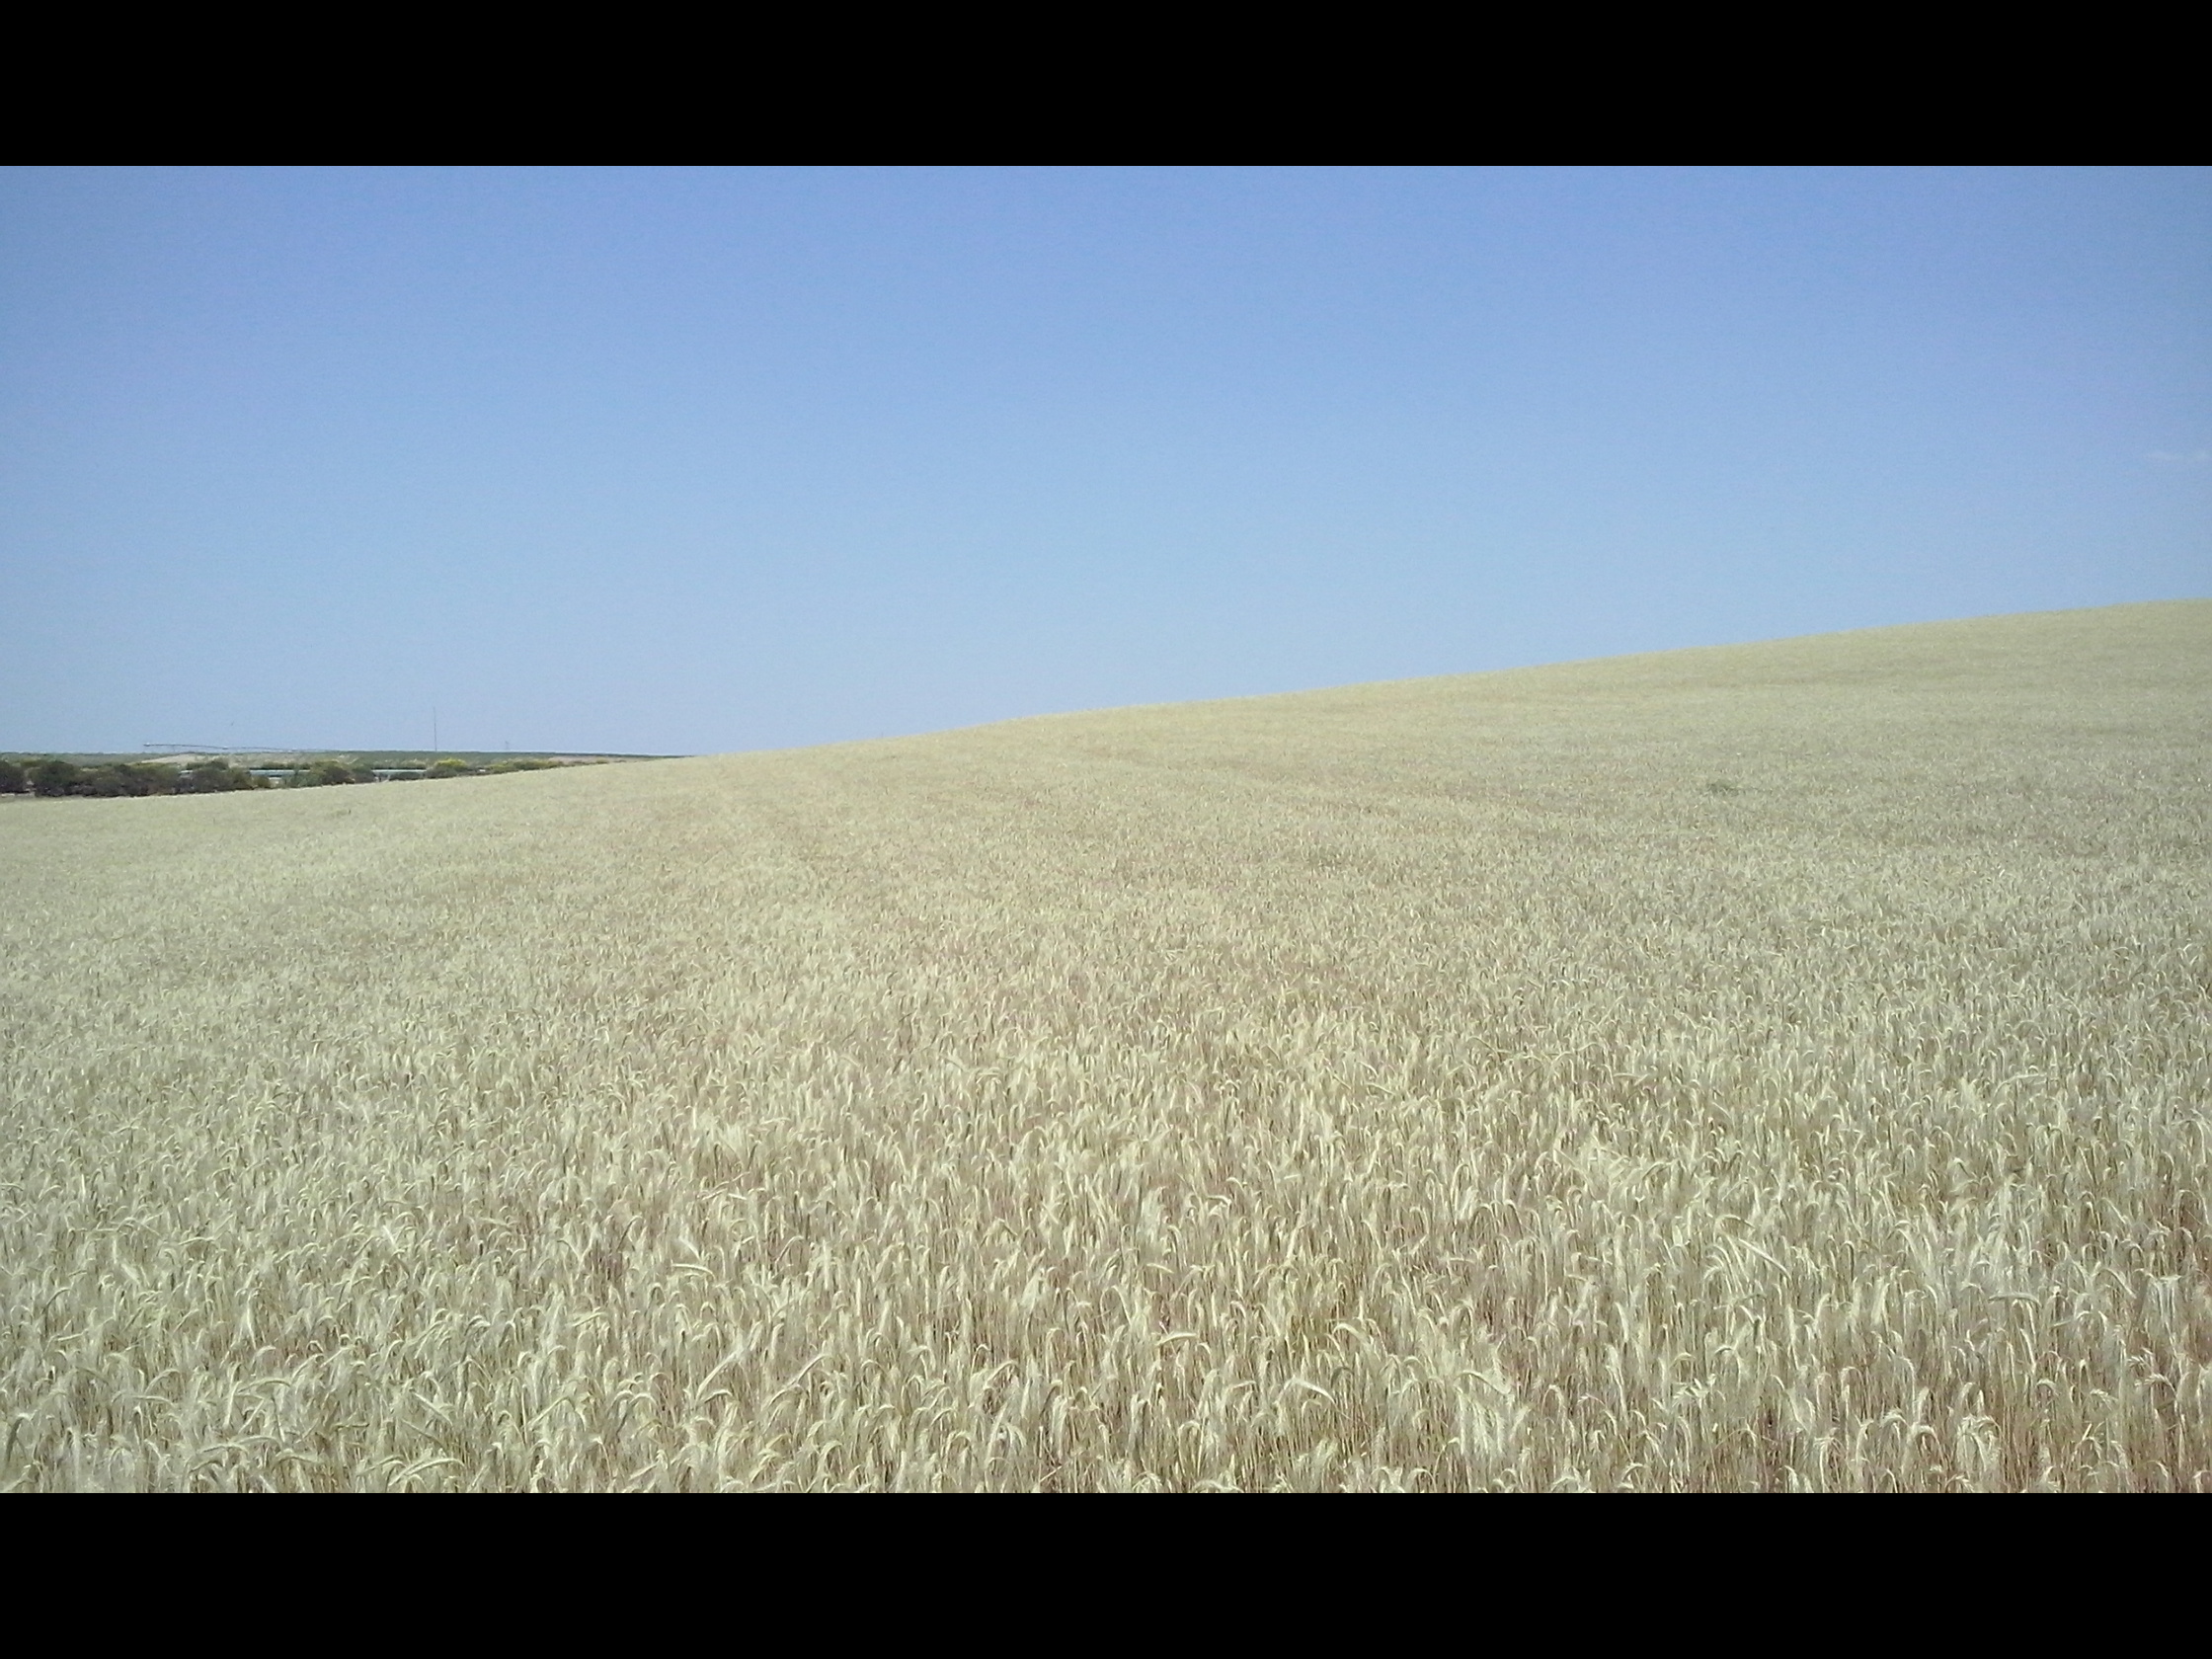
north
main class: Cropland
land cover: Rye
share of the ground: > 75 %
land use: Agriculture (excluding fallow land and kitchen gardens)
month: June
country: ES
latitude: 41.5091
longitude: -5.1349
